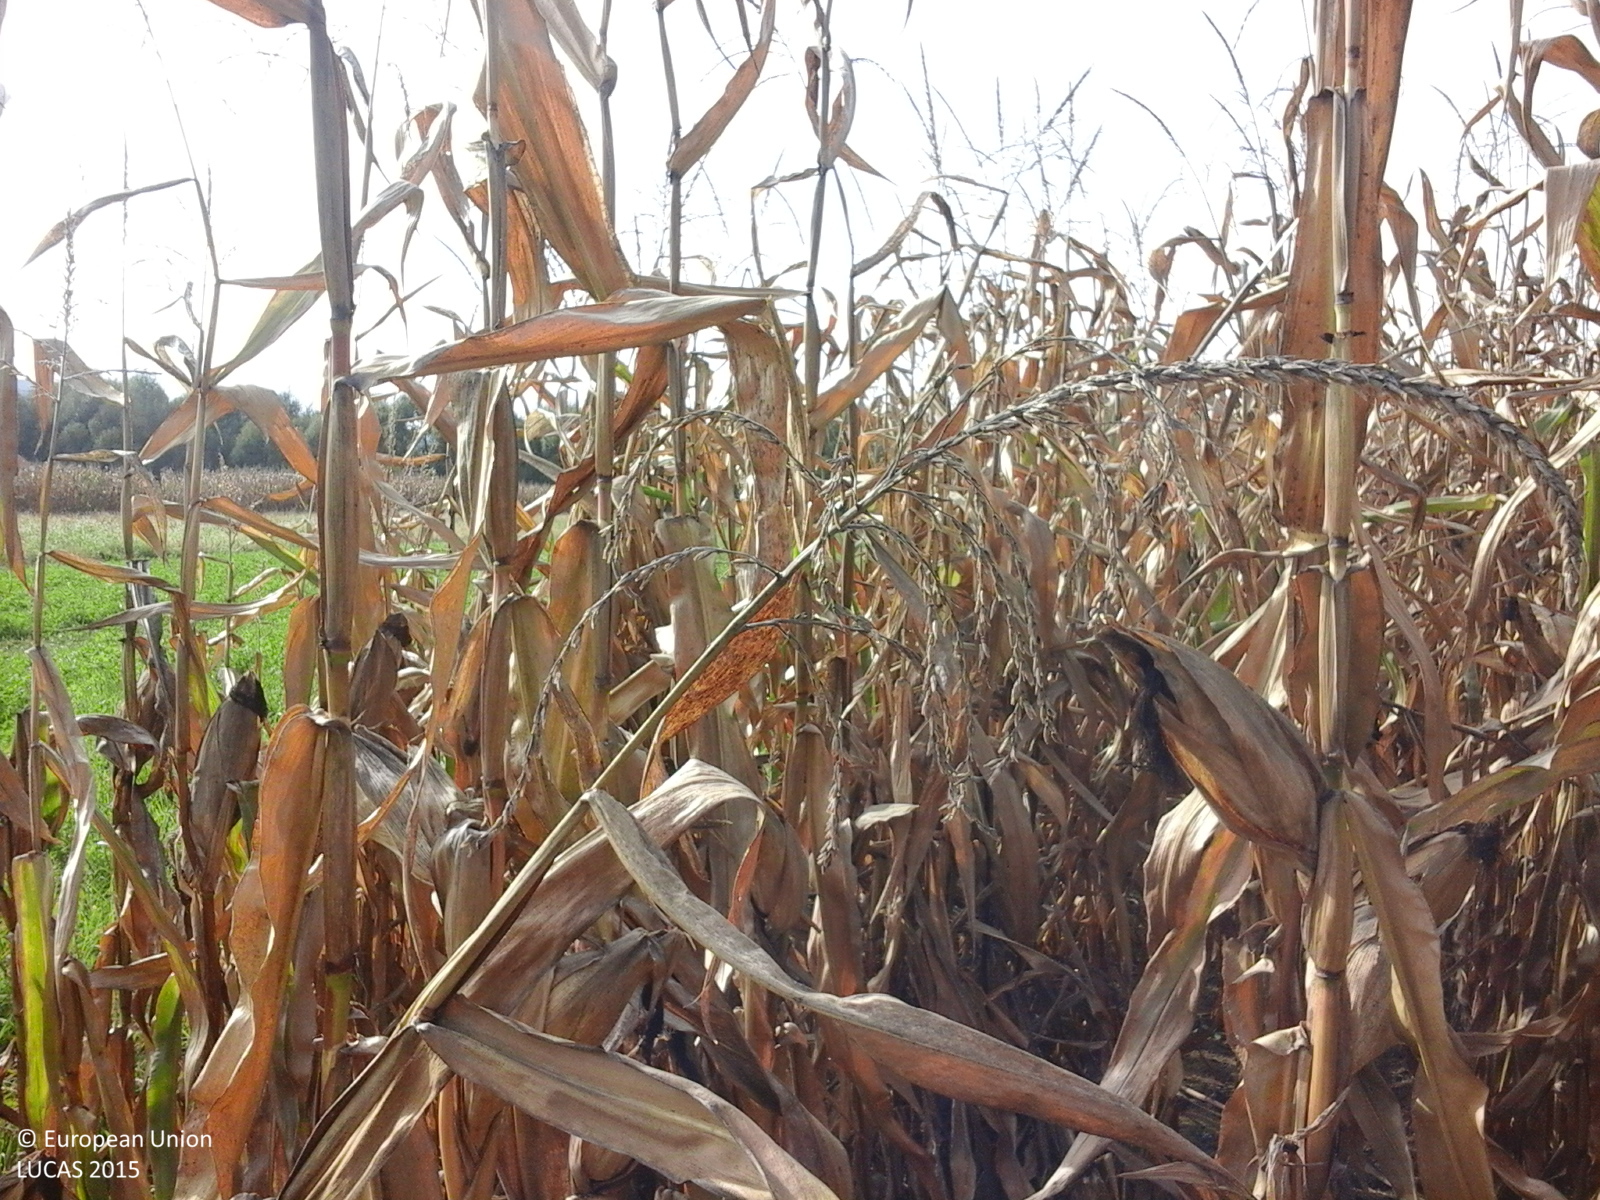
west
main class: Cropland
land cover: Maize
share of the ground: > 75 %
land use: Agriculture (excluding fallow land and kitchen gardens)
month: October
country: RO
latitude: 46.3214
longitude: 25.3118
